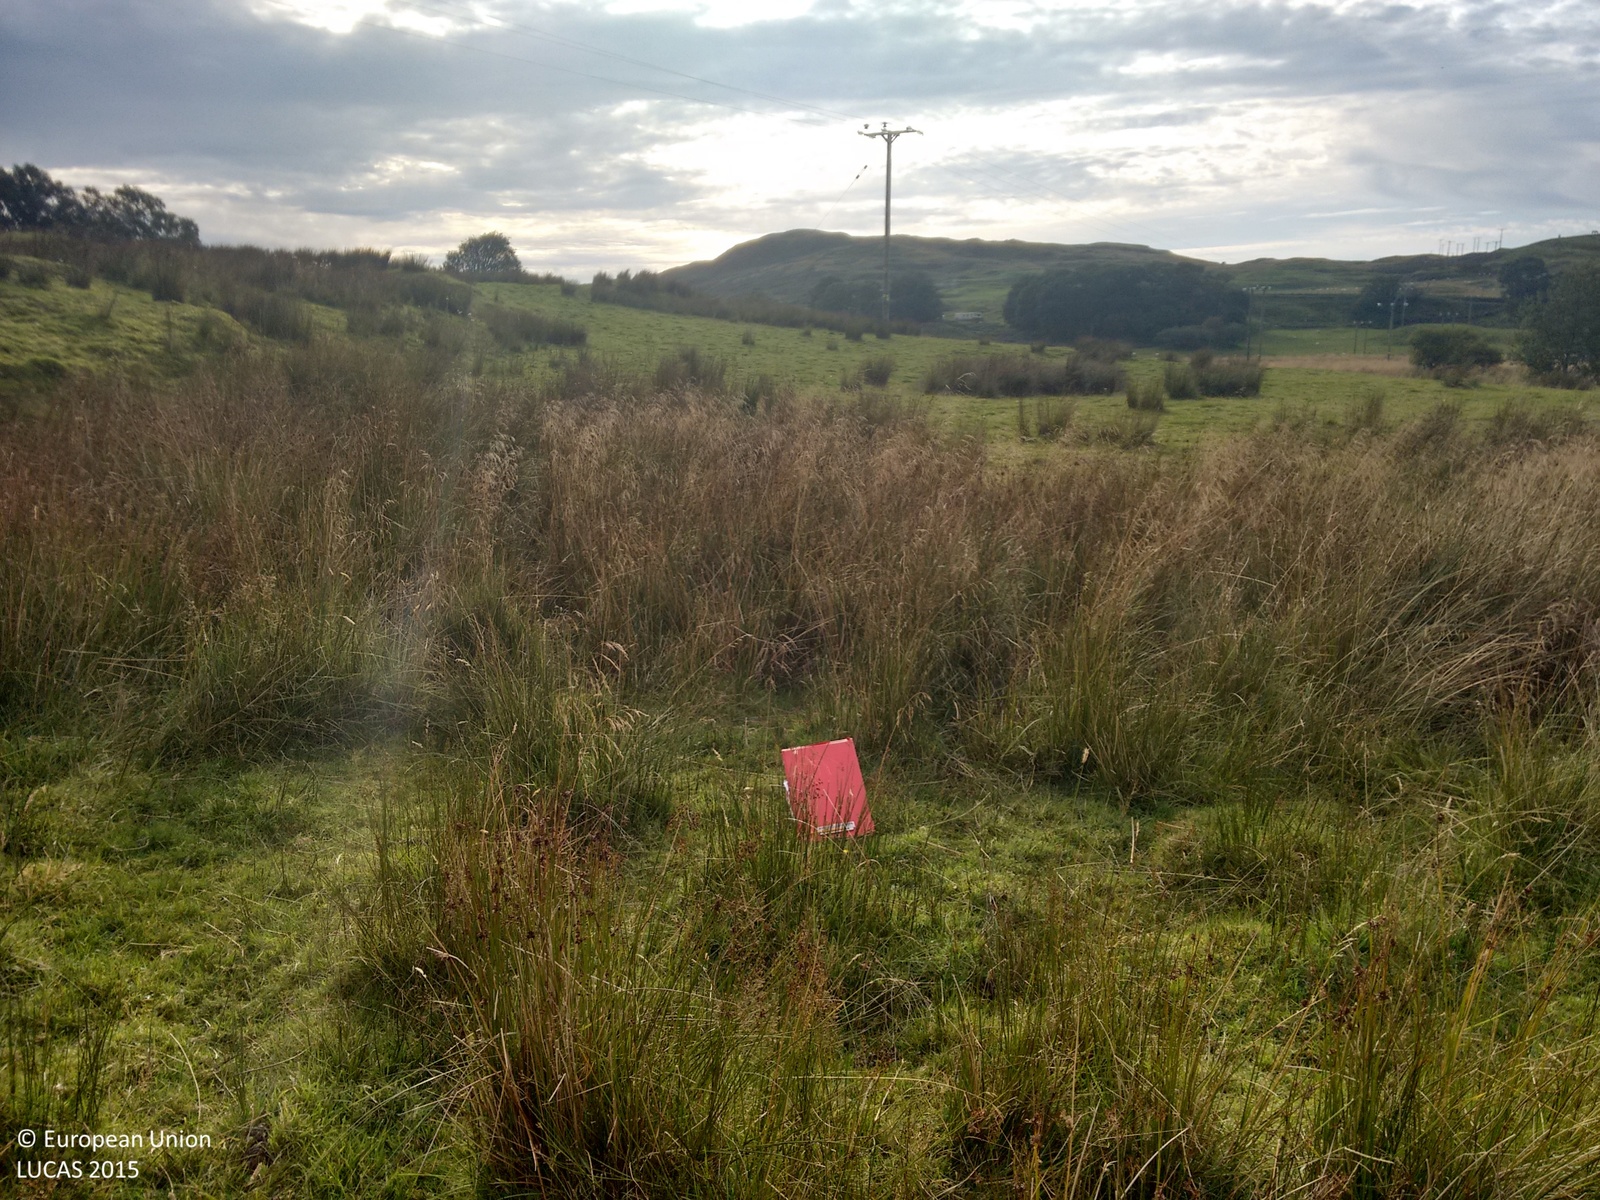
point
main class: Grassland
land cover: Grassland without tree/shrub cover
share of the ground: > 75 %
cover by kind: herbaceous plants 95 %, shrubs 5 %
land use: Agriculture (excluding fallow land and kitchen gardens)
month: September
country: GB
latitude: 56.4059
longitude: -5.3995
